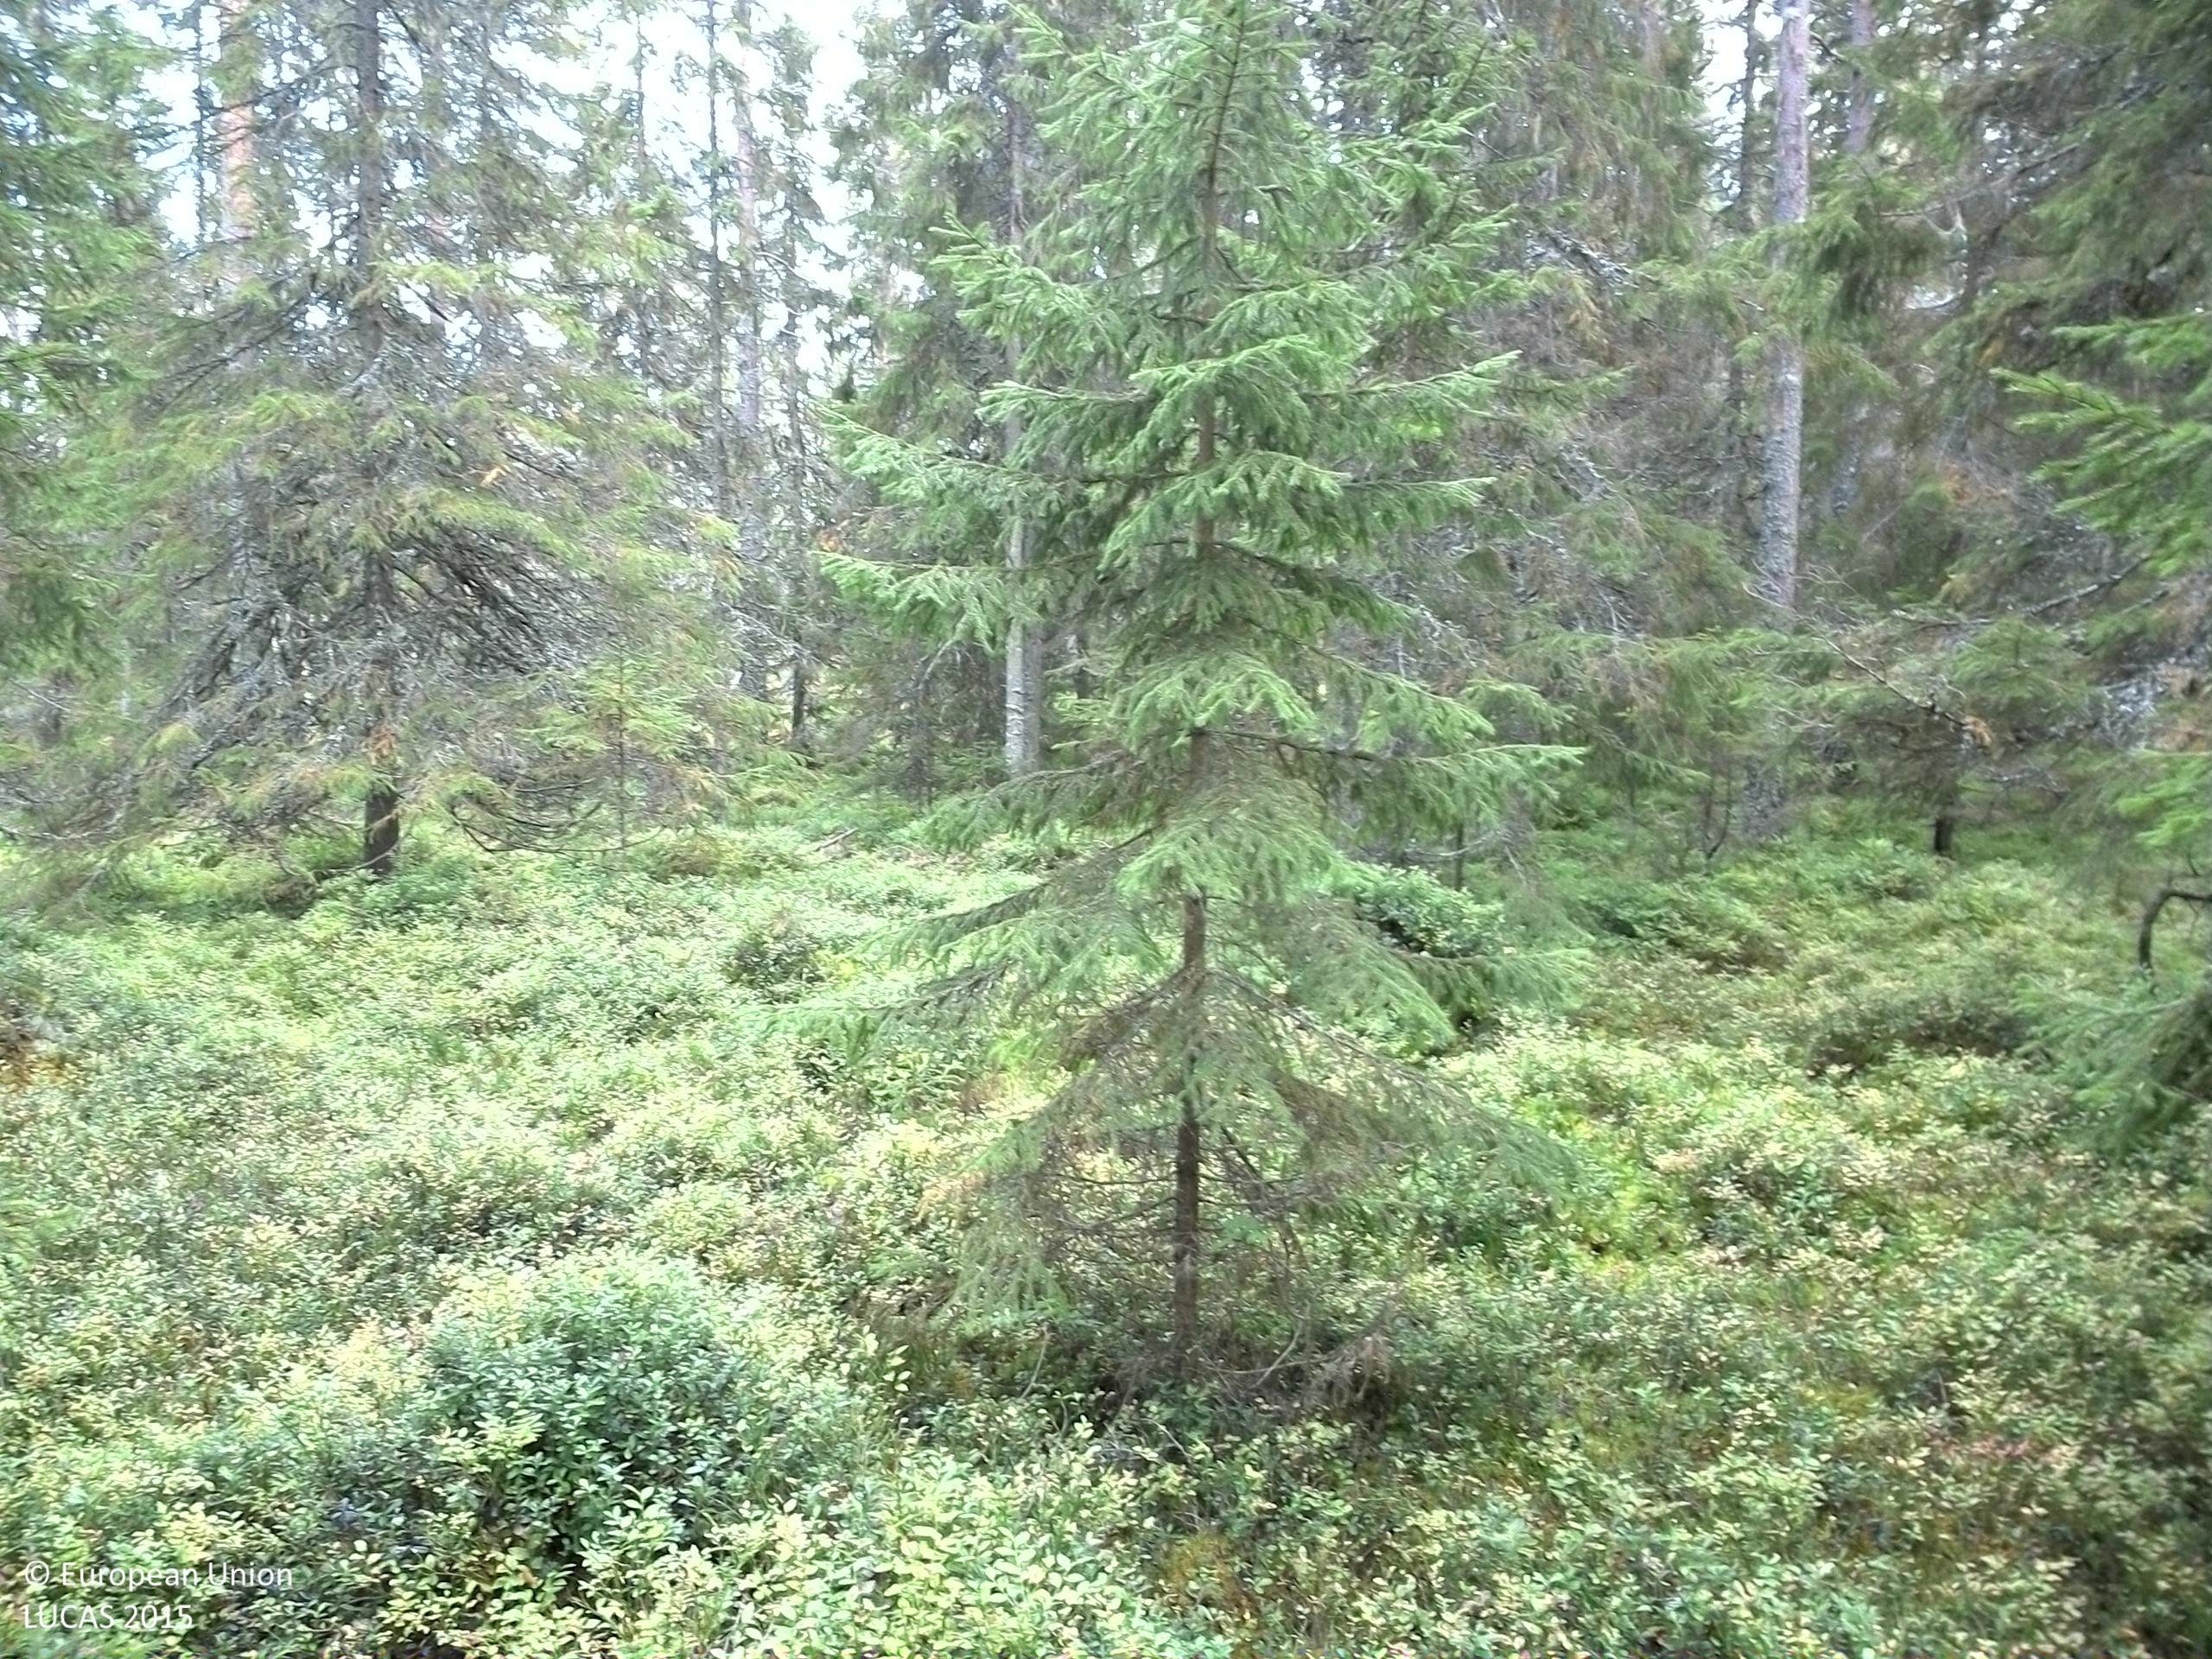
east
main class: Woodland
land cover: Other coniferous woodland
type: boreal forest
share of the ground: 50 - 75 %
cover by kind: coniferous forest trees 65 %, shrubs 30 %, lichens and mosses 5 %
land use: Forestry
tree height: > 5 m
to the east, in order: Other coniferous woodland; Pine dominated coniferous woodland; Peatbogs; Pine dominated coniferous woodland; Other coniferous woodland; Spruce dominated coniferous woodland
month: September
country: SE
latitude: 61.3223
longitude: 15.4207
